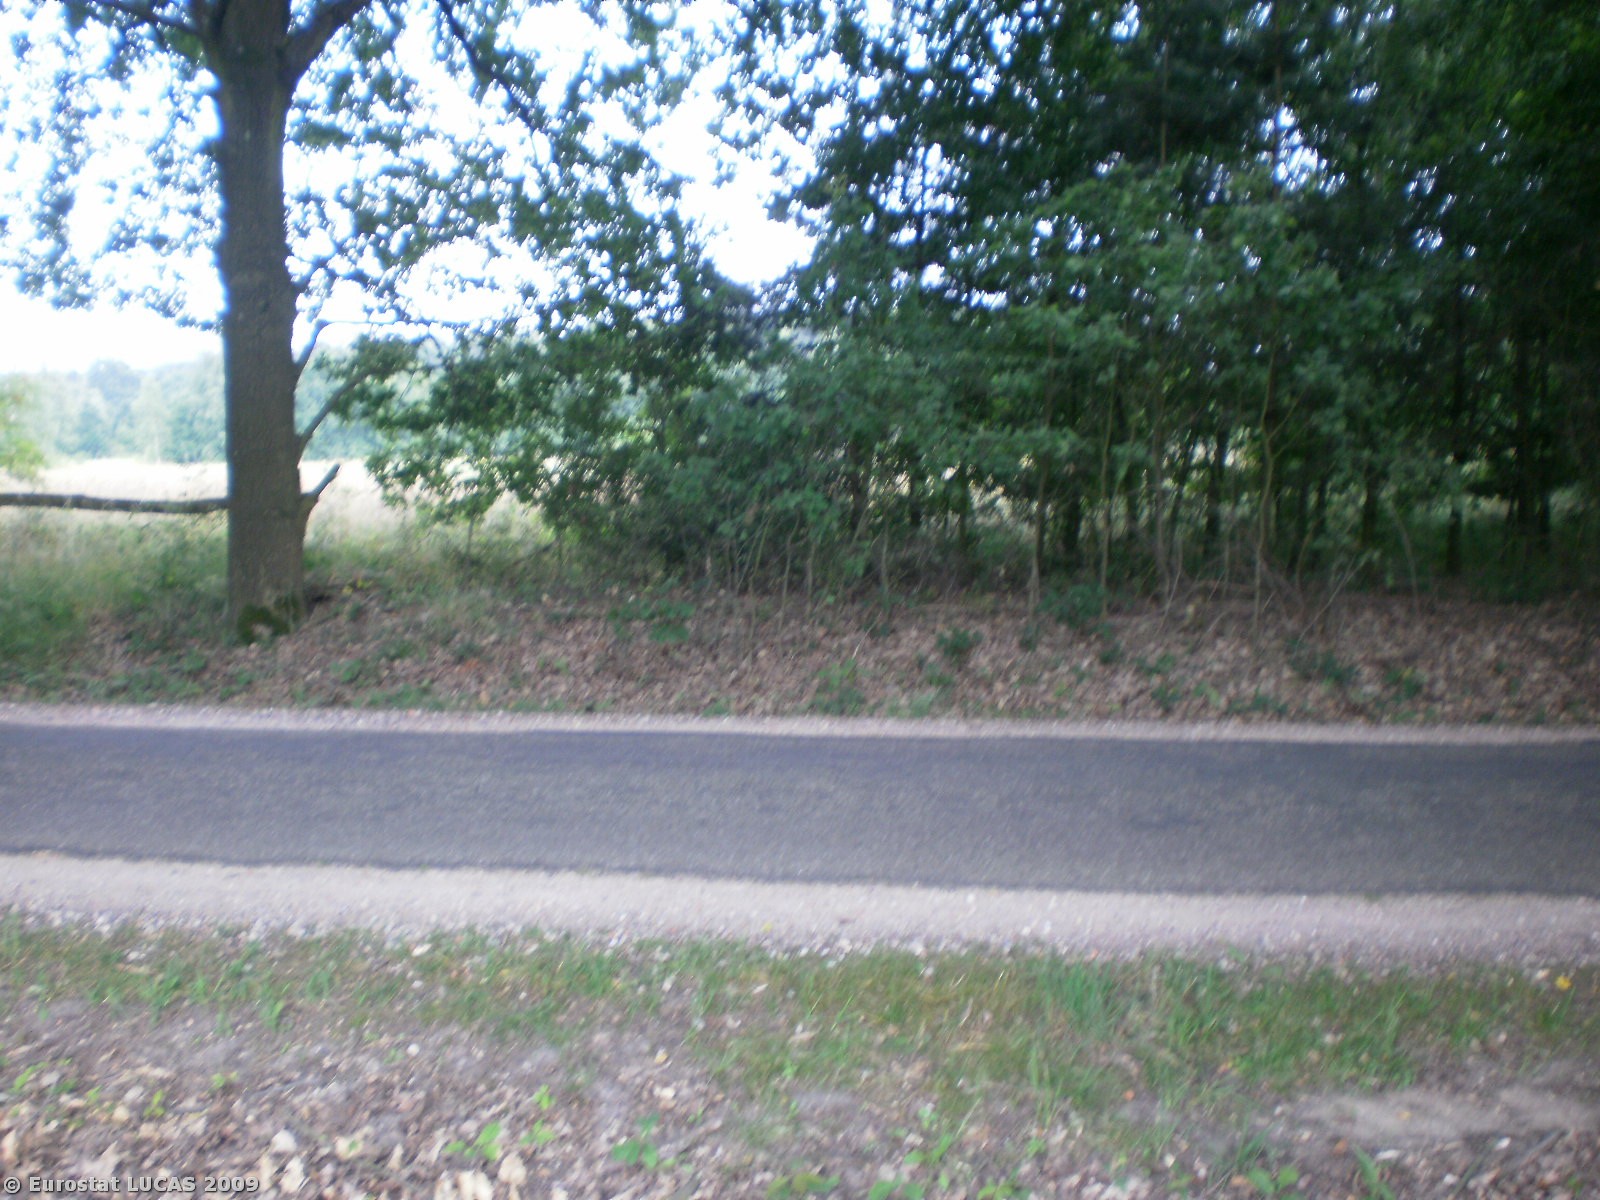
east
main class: Grassland
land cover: Grassland without tree/shrub cover
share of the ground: > 75 %
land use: Agriculture (excluding fallow land and kitchen gardens)
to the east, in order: Grassland without tree/shrub cover; Grass margins; Lines of trees; Grass margins; Paved roads, cycling and walking lanes; Grass margins; Lines of trees; Groves; Grassland without tree/shrub cover; Groves; Grass margins; Grassland without tree/shrub cover; Grass margins; Groves; Grassland without tree/shrub cover; Groves; Tracks; Mixed woodland
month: July
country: BE
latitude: 51.1555
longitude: 5.4371
